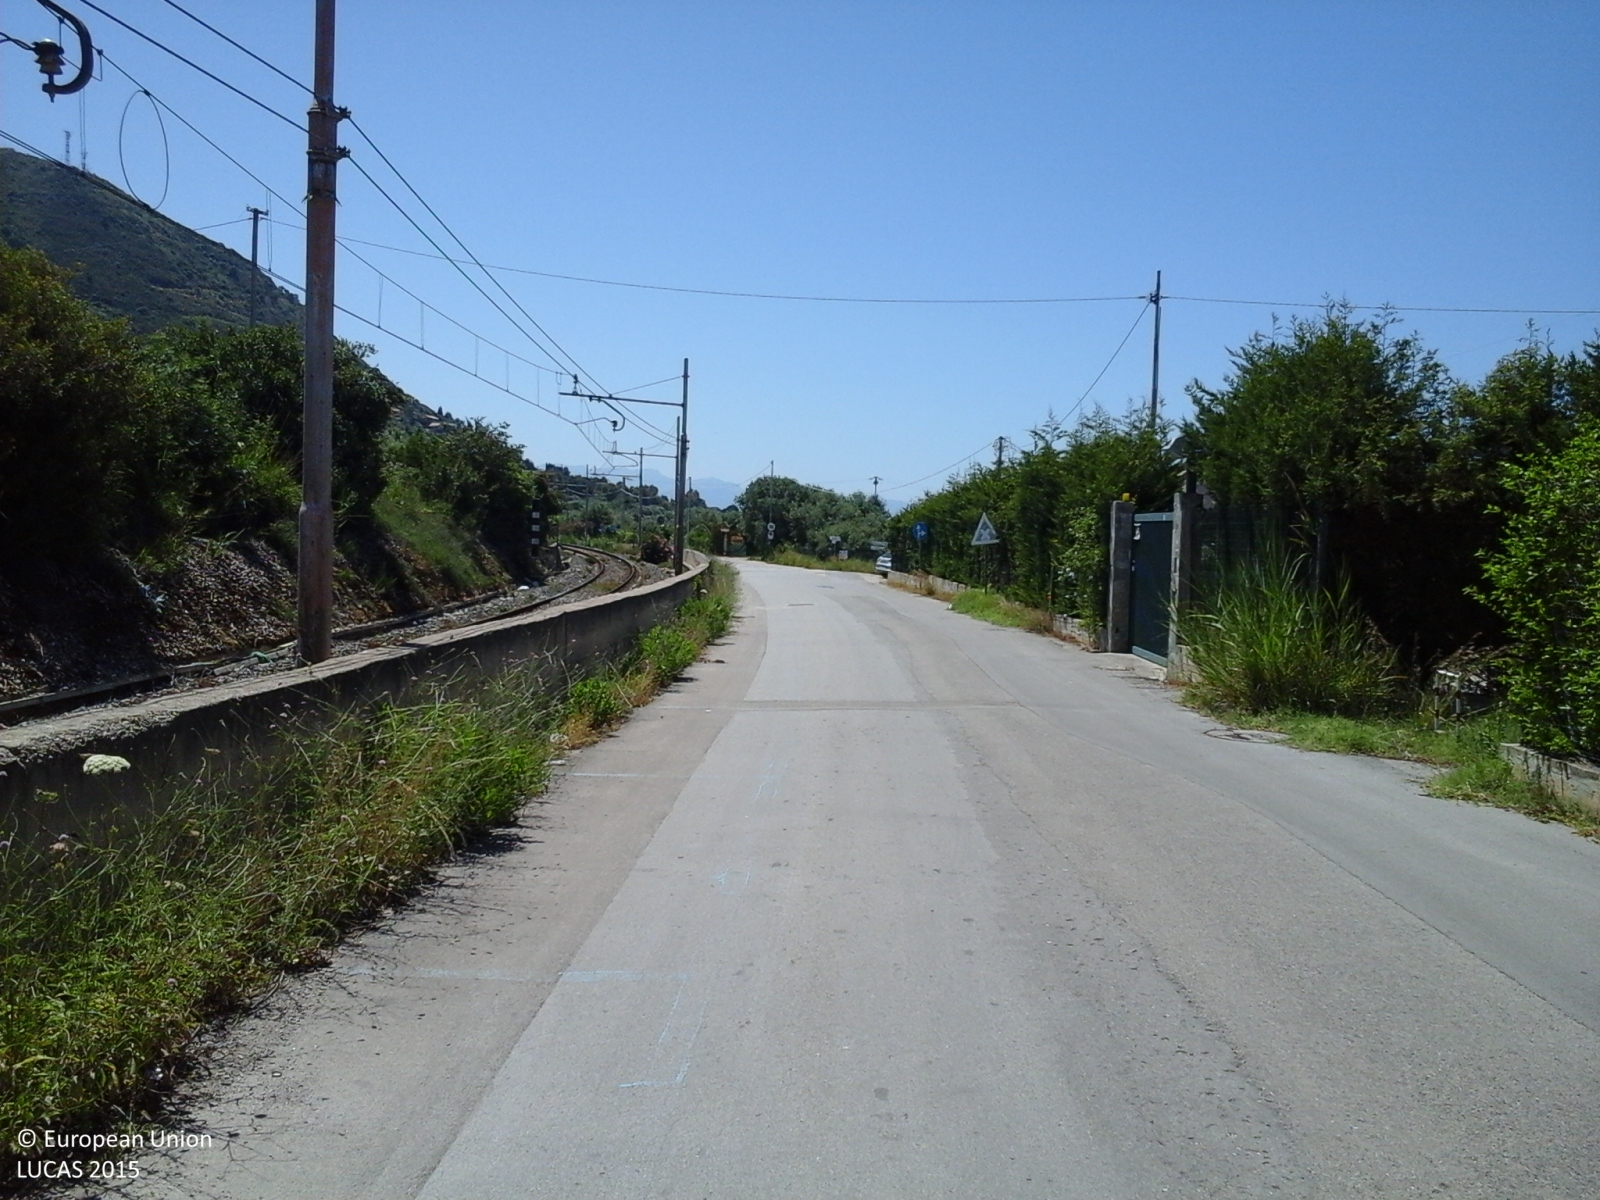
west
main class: Woodland
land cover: Broadleaved woodland
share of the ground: > 75 %
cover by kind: broadleaved forest trees 85 %, shrubs 10 %, herbaceous plants 5 %
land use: Residential
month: May
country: IT
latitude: 38.0280
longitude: 13.9712
